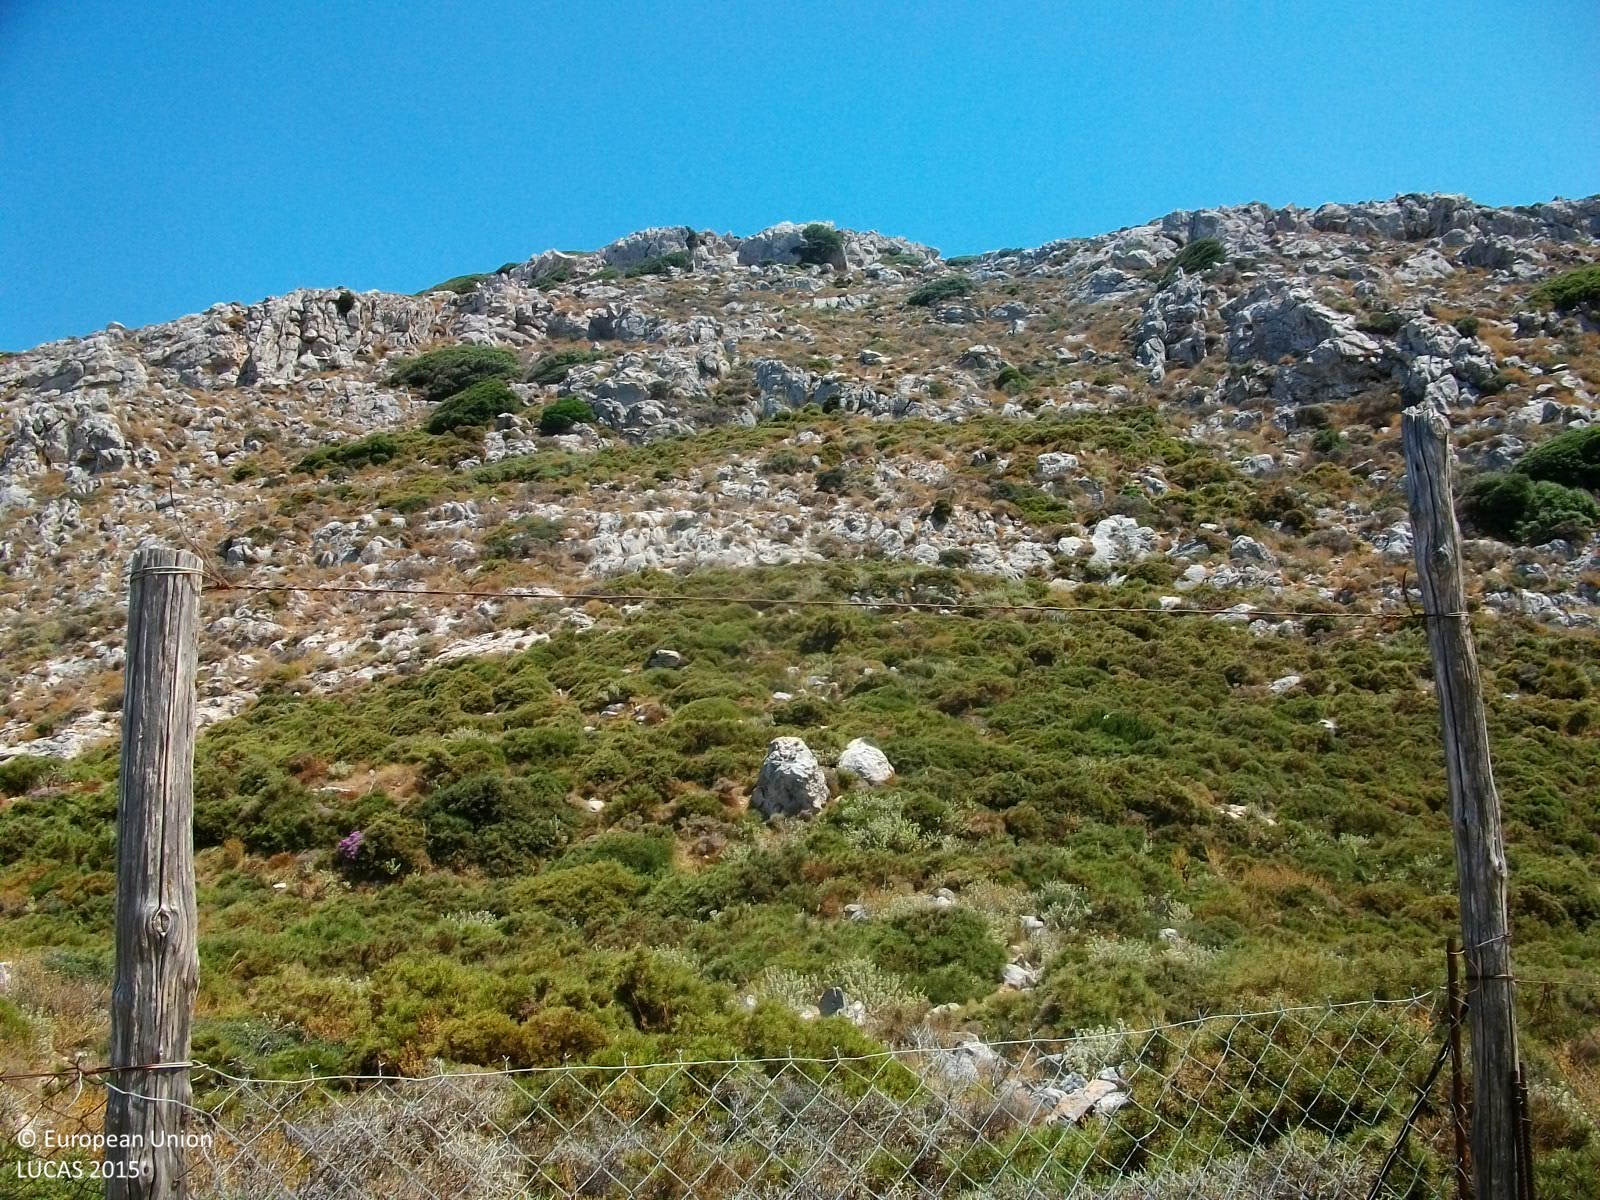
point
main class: Shrubland
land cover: Shrubland without tree cover
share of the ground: 50 - 75 %
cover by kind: shrubs 60 %, unconsolidated bare surface 40 %
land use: Semi-natural and natural areas not in use
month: August
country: GR
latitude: 35.1074
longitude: 26.1172
